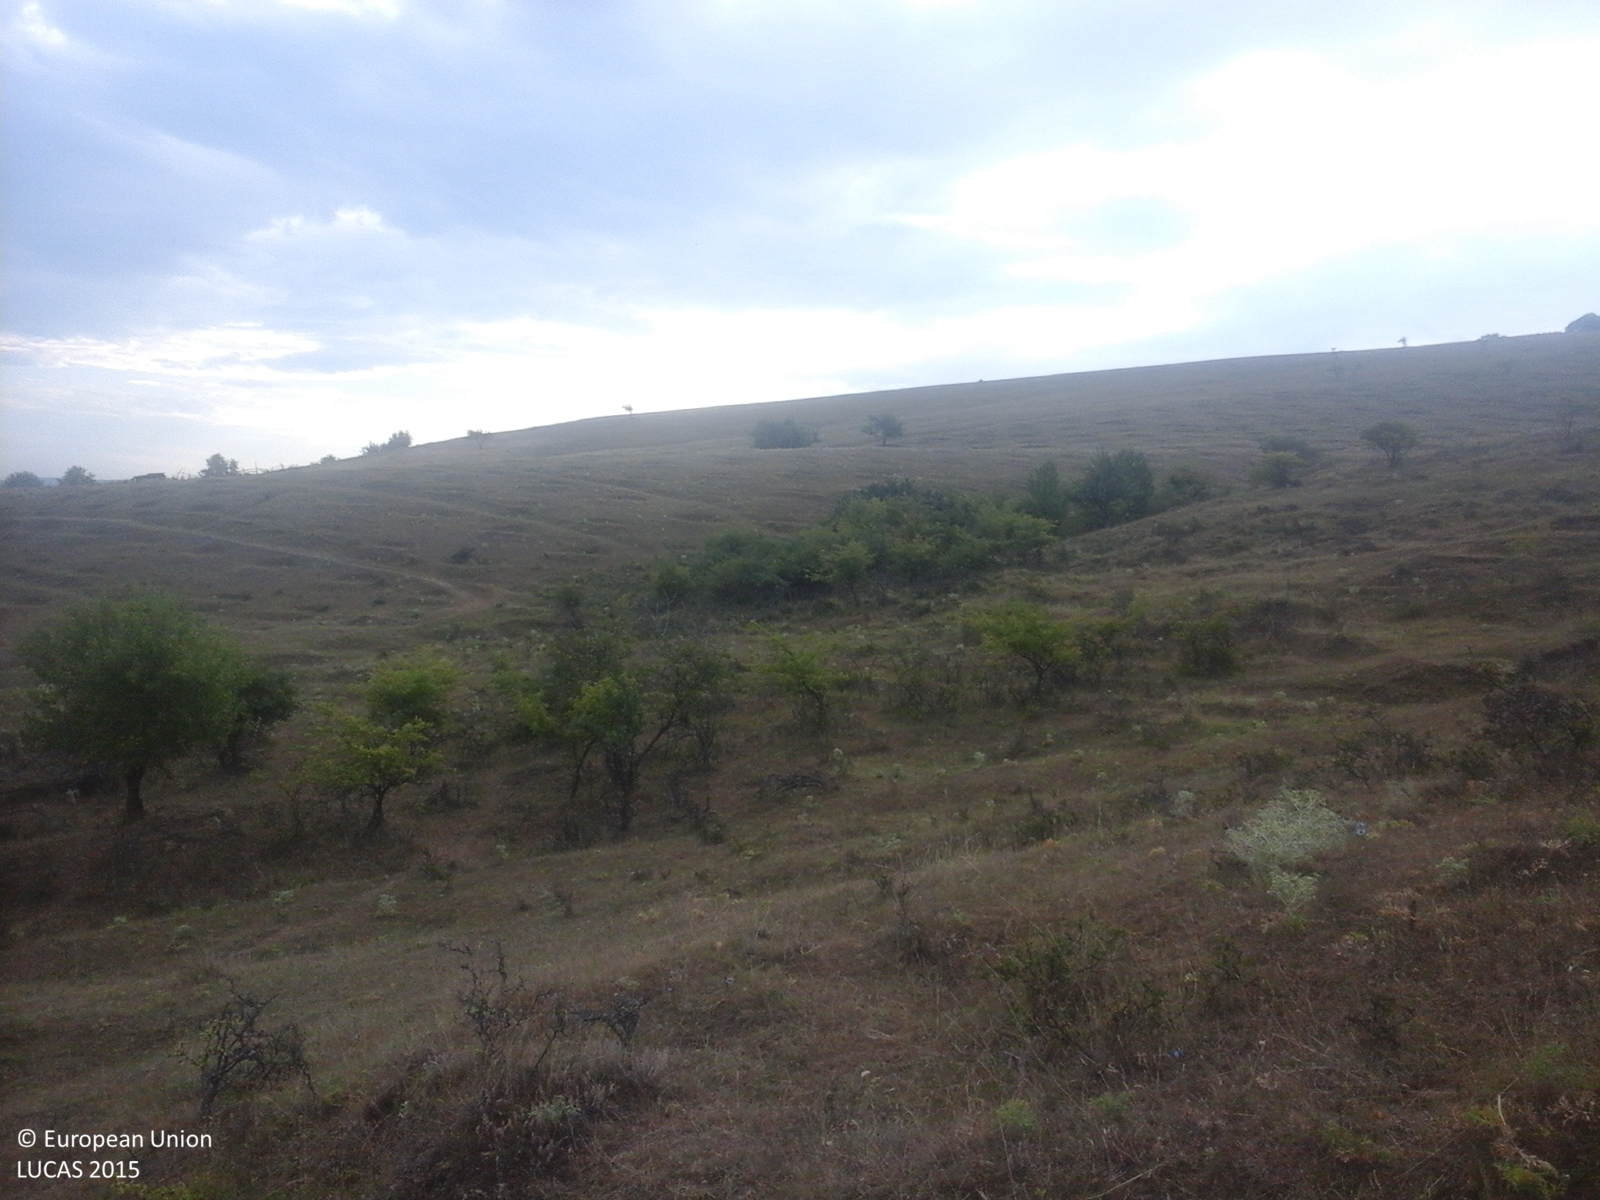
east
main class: Grassland
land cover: Grassland with sparse tree/shrub cover
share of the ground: > 75 %
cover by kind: herbaceous plants 85 %, shrubs 10 %, broadleaved forest trees 5 %
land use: Agriculture (excluding fallow land and kitchen gardens)
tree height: < 5 m
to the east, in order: Grassland with sparse tree/shrub cover; Shrubland with sparse tree cover; Grassland without tree/shrub cover
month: July
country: RO
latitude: 46.5791
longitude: 27.8832
